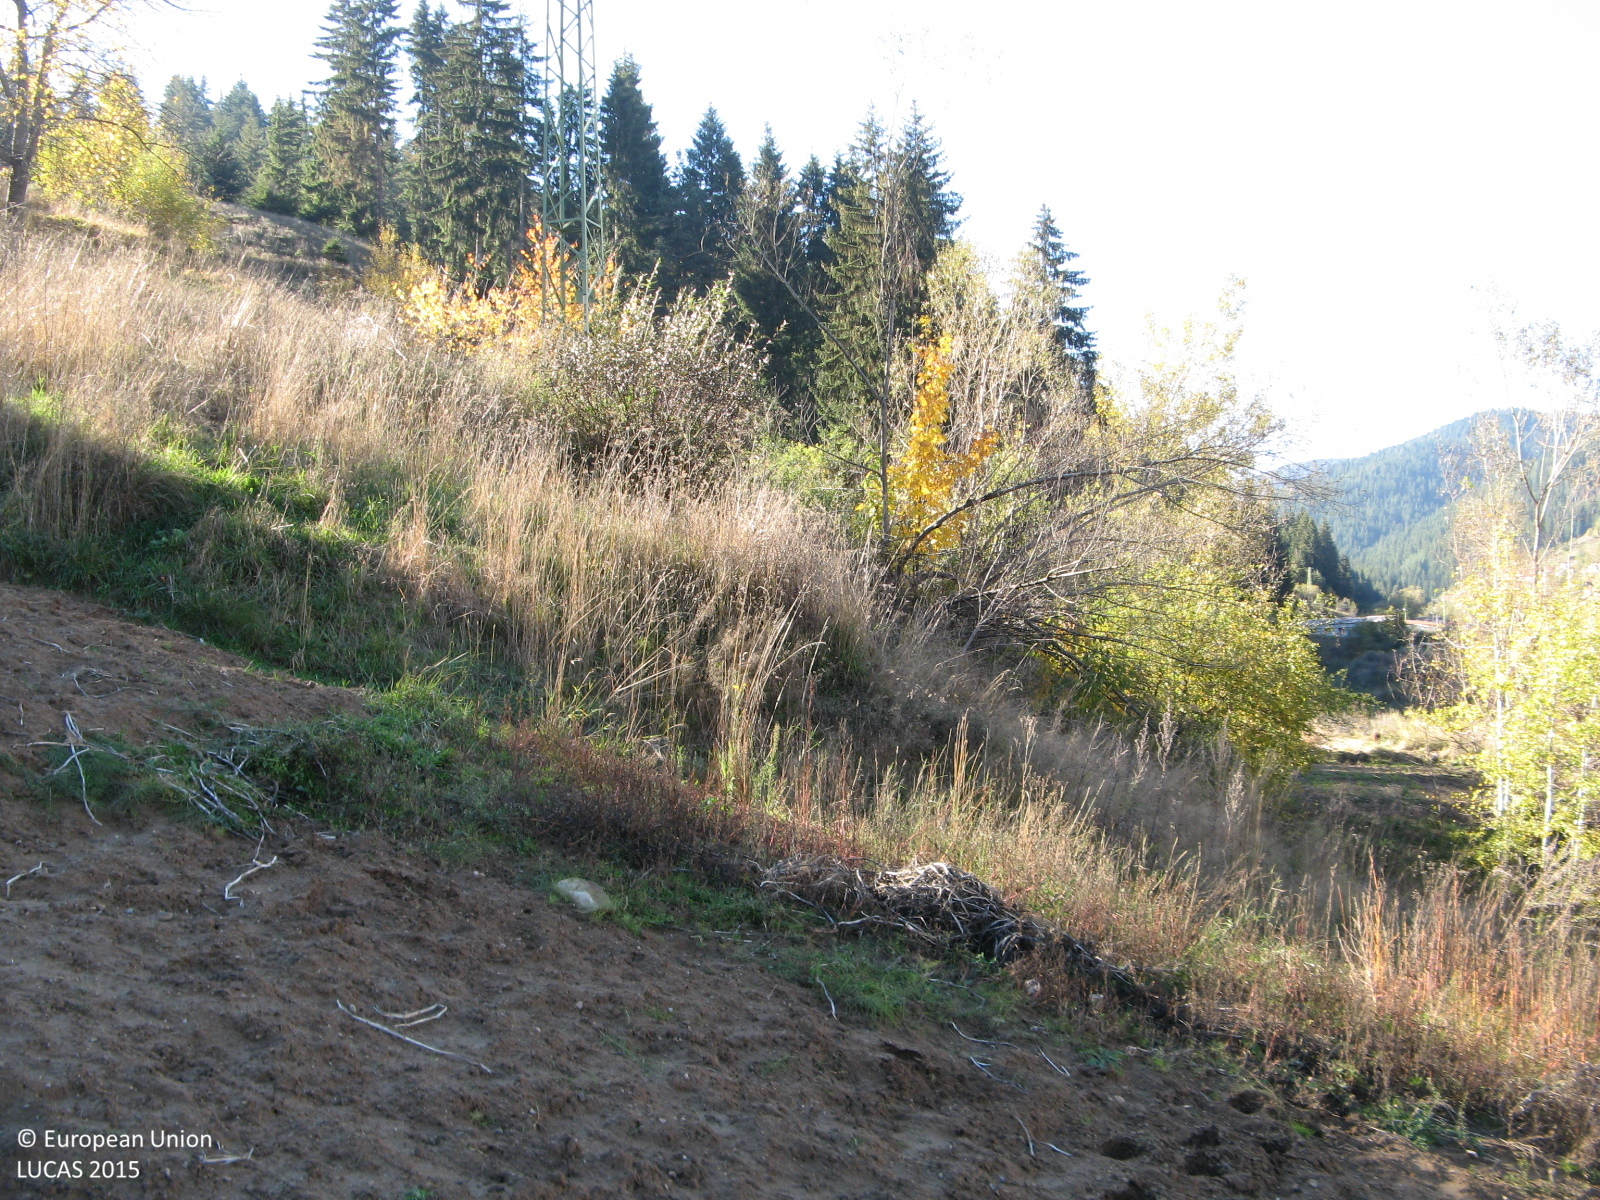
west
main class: Cropland
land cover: Potatoes
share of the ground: < 10 %
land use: Agriculture (excluding fallow land and kitchen gardens)
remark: Harvested field
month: October
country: BG
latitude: 41.7251
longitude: 24.6749
